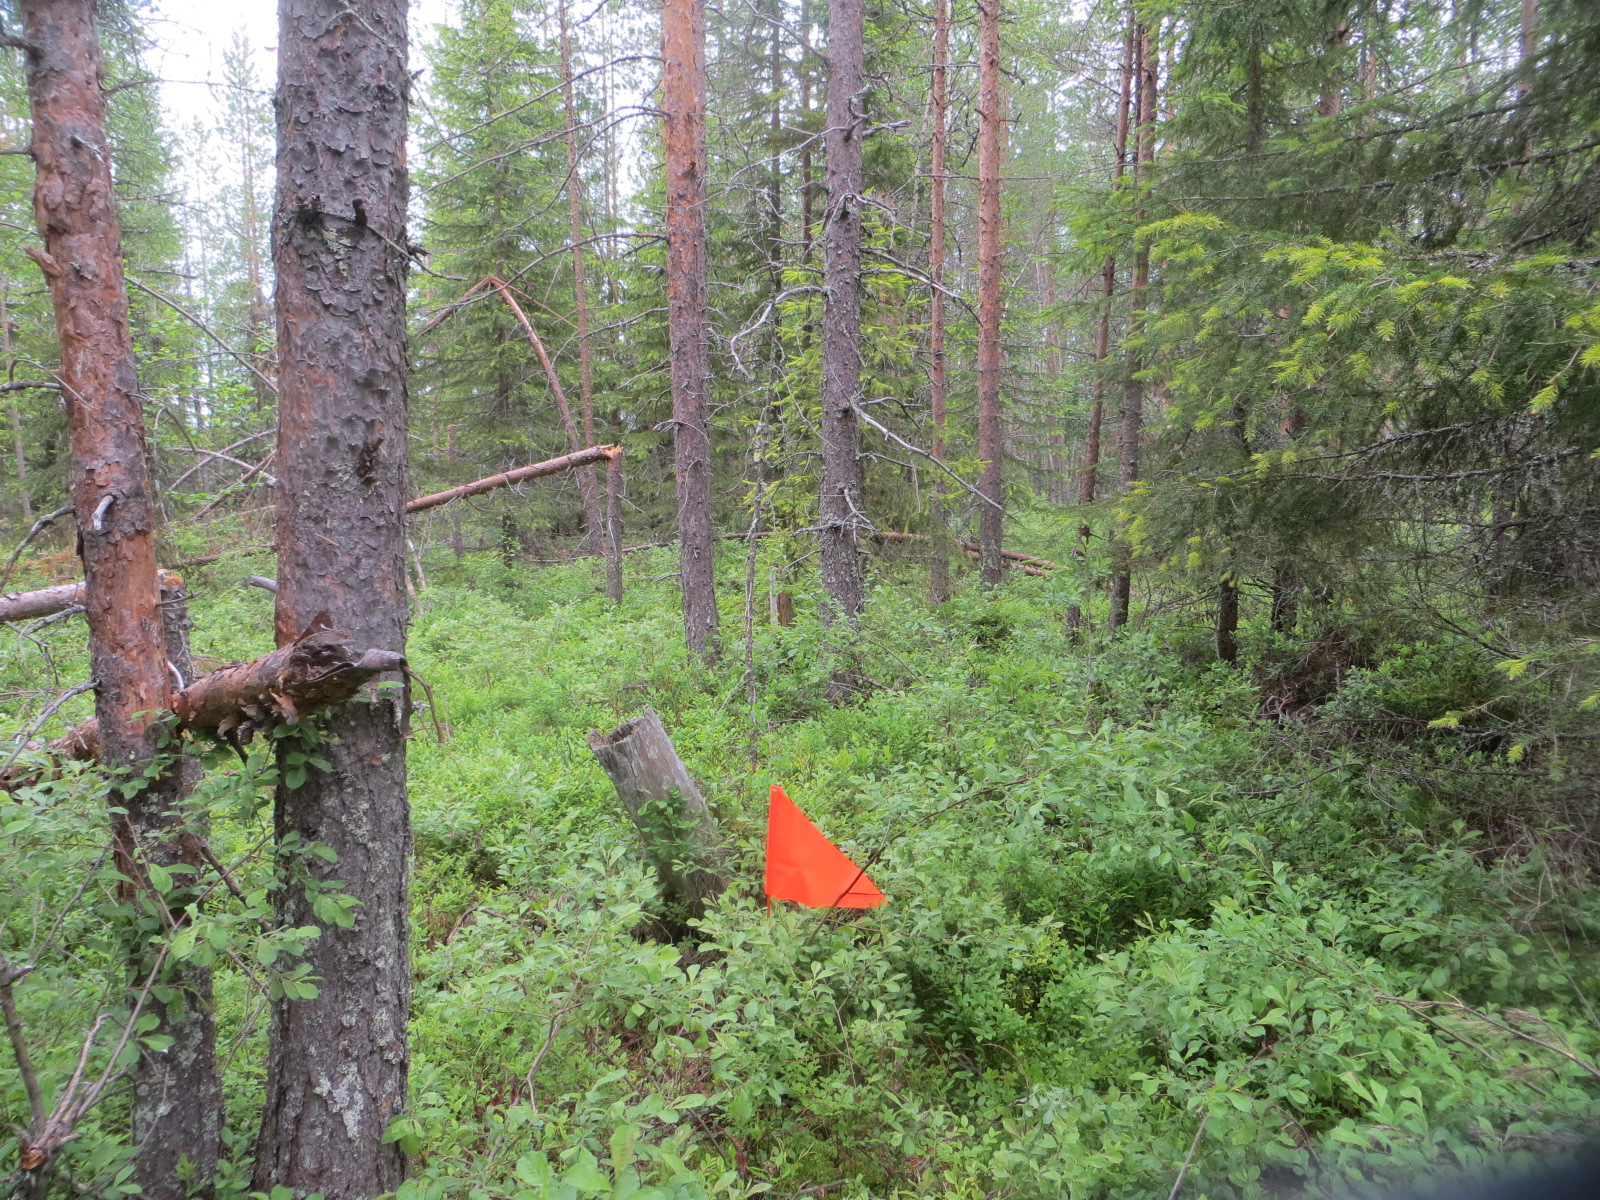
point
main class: Woodland
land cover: Other coniferous woodland
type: boreal forest
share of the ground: 50 - 75 %
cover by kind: coniferous forest trees 60 %, shrubs 30 %, broadleaved forest trees 10 %
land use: Forestry
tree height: > 5 m
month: July
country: FI
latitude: 65.7339
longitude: 25.3576
